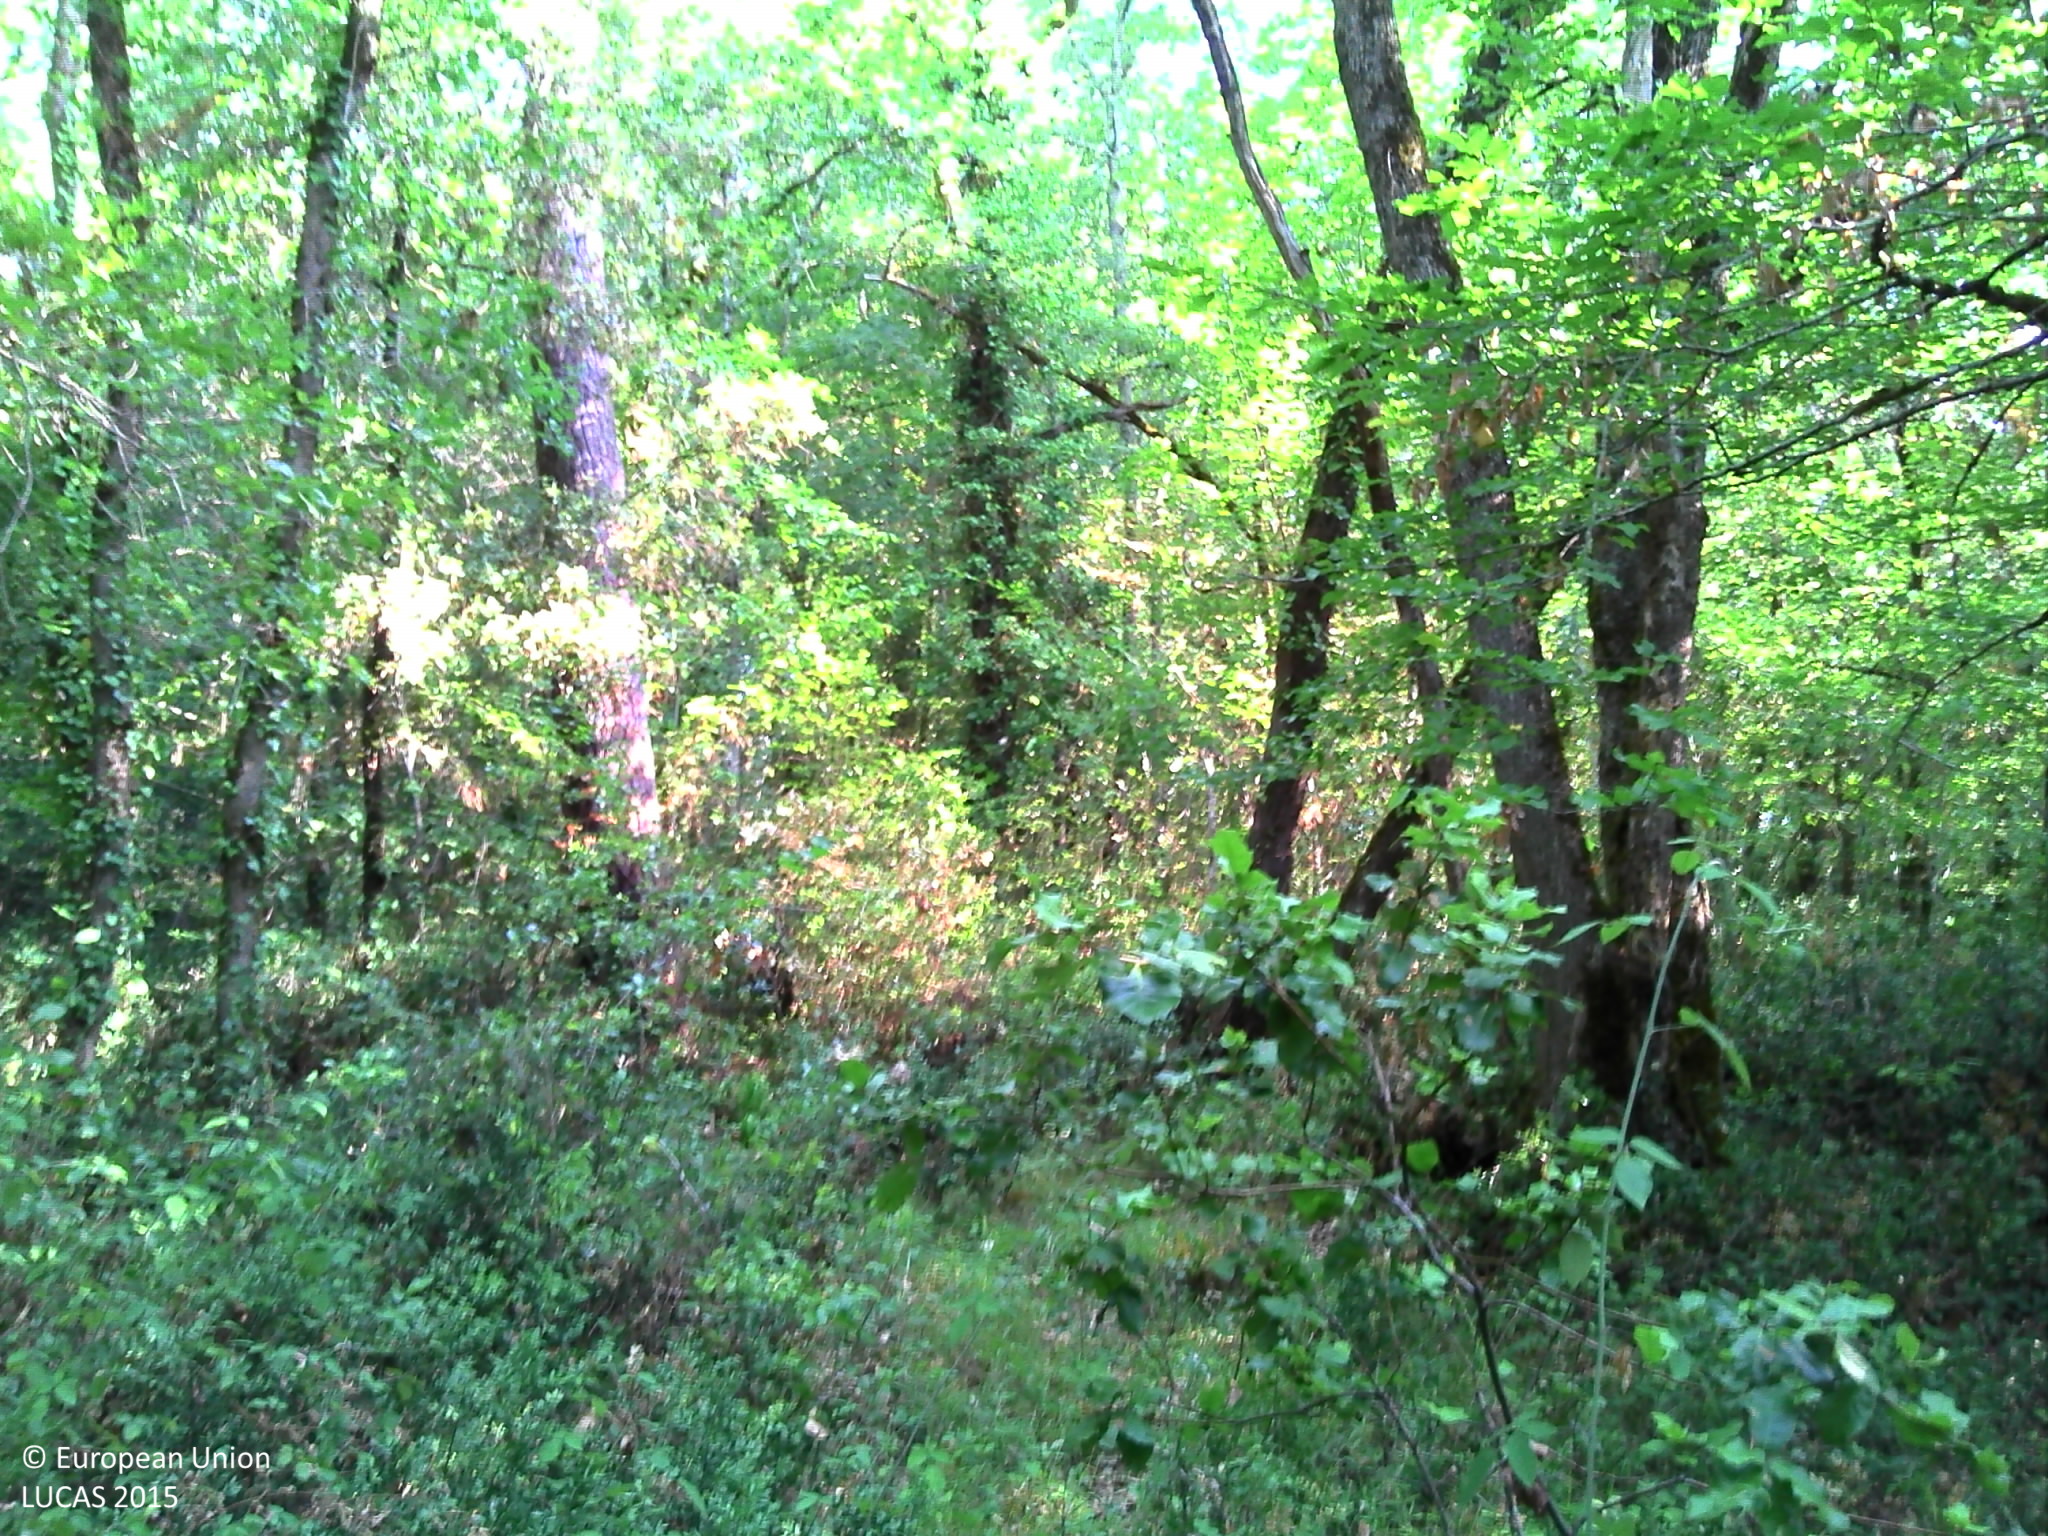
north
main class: Woodland
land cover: Broadleaved woodland
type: acidophilous oak and oak-birch forest
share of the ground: > 75 %
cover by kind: broadleaved forest trees 80 %, herbaceous plants 10 %, lichens and mosses 10 %
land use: Forestry
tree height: > 5 m
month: August
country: FR
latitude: 44.8308
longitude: 1.2296
